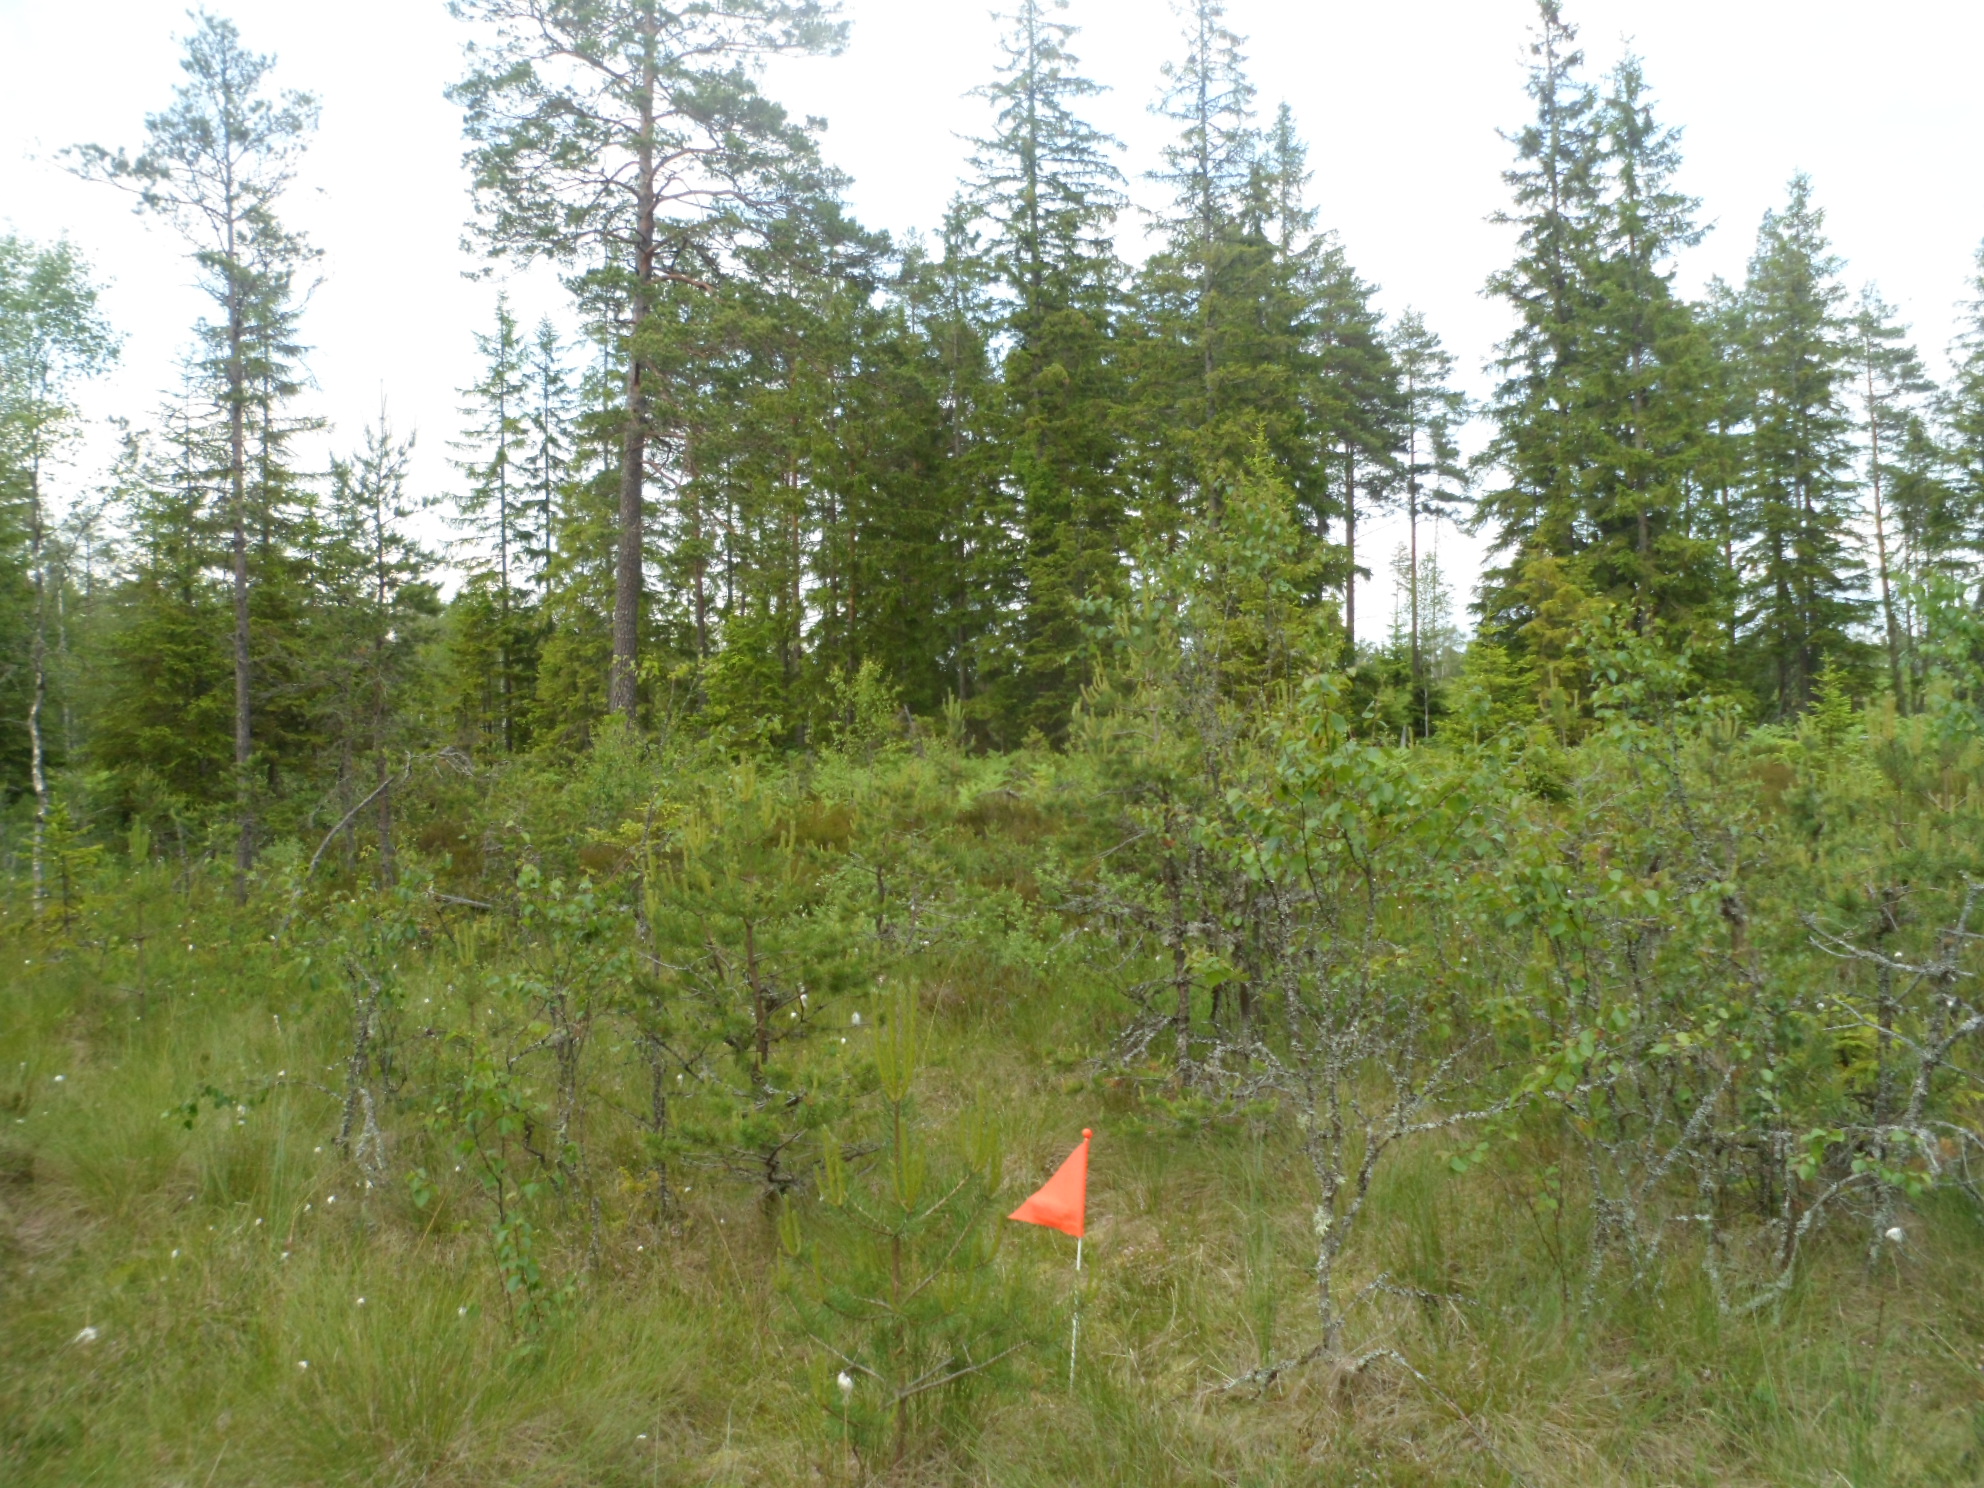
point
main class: Woodland
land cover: Pine dominated mixed woodland
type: boreal forest
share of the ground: 25 - 50 %
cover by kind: coniferous forest trees 25 %, broadleaved forest trees 25 %, herbaceous plants 20 %, lichens and mosses 20 %, shrubs 10 %
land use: Forestry
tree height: > 5 m
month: June
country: SE
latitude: 57.1182
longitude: 15.4310
